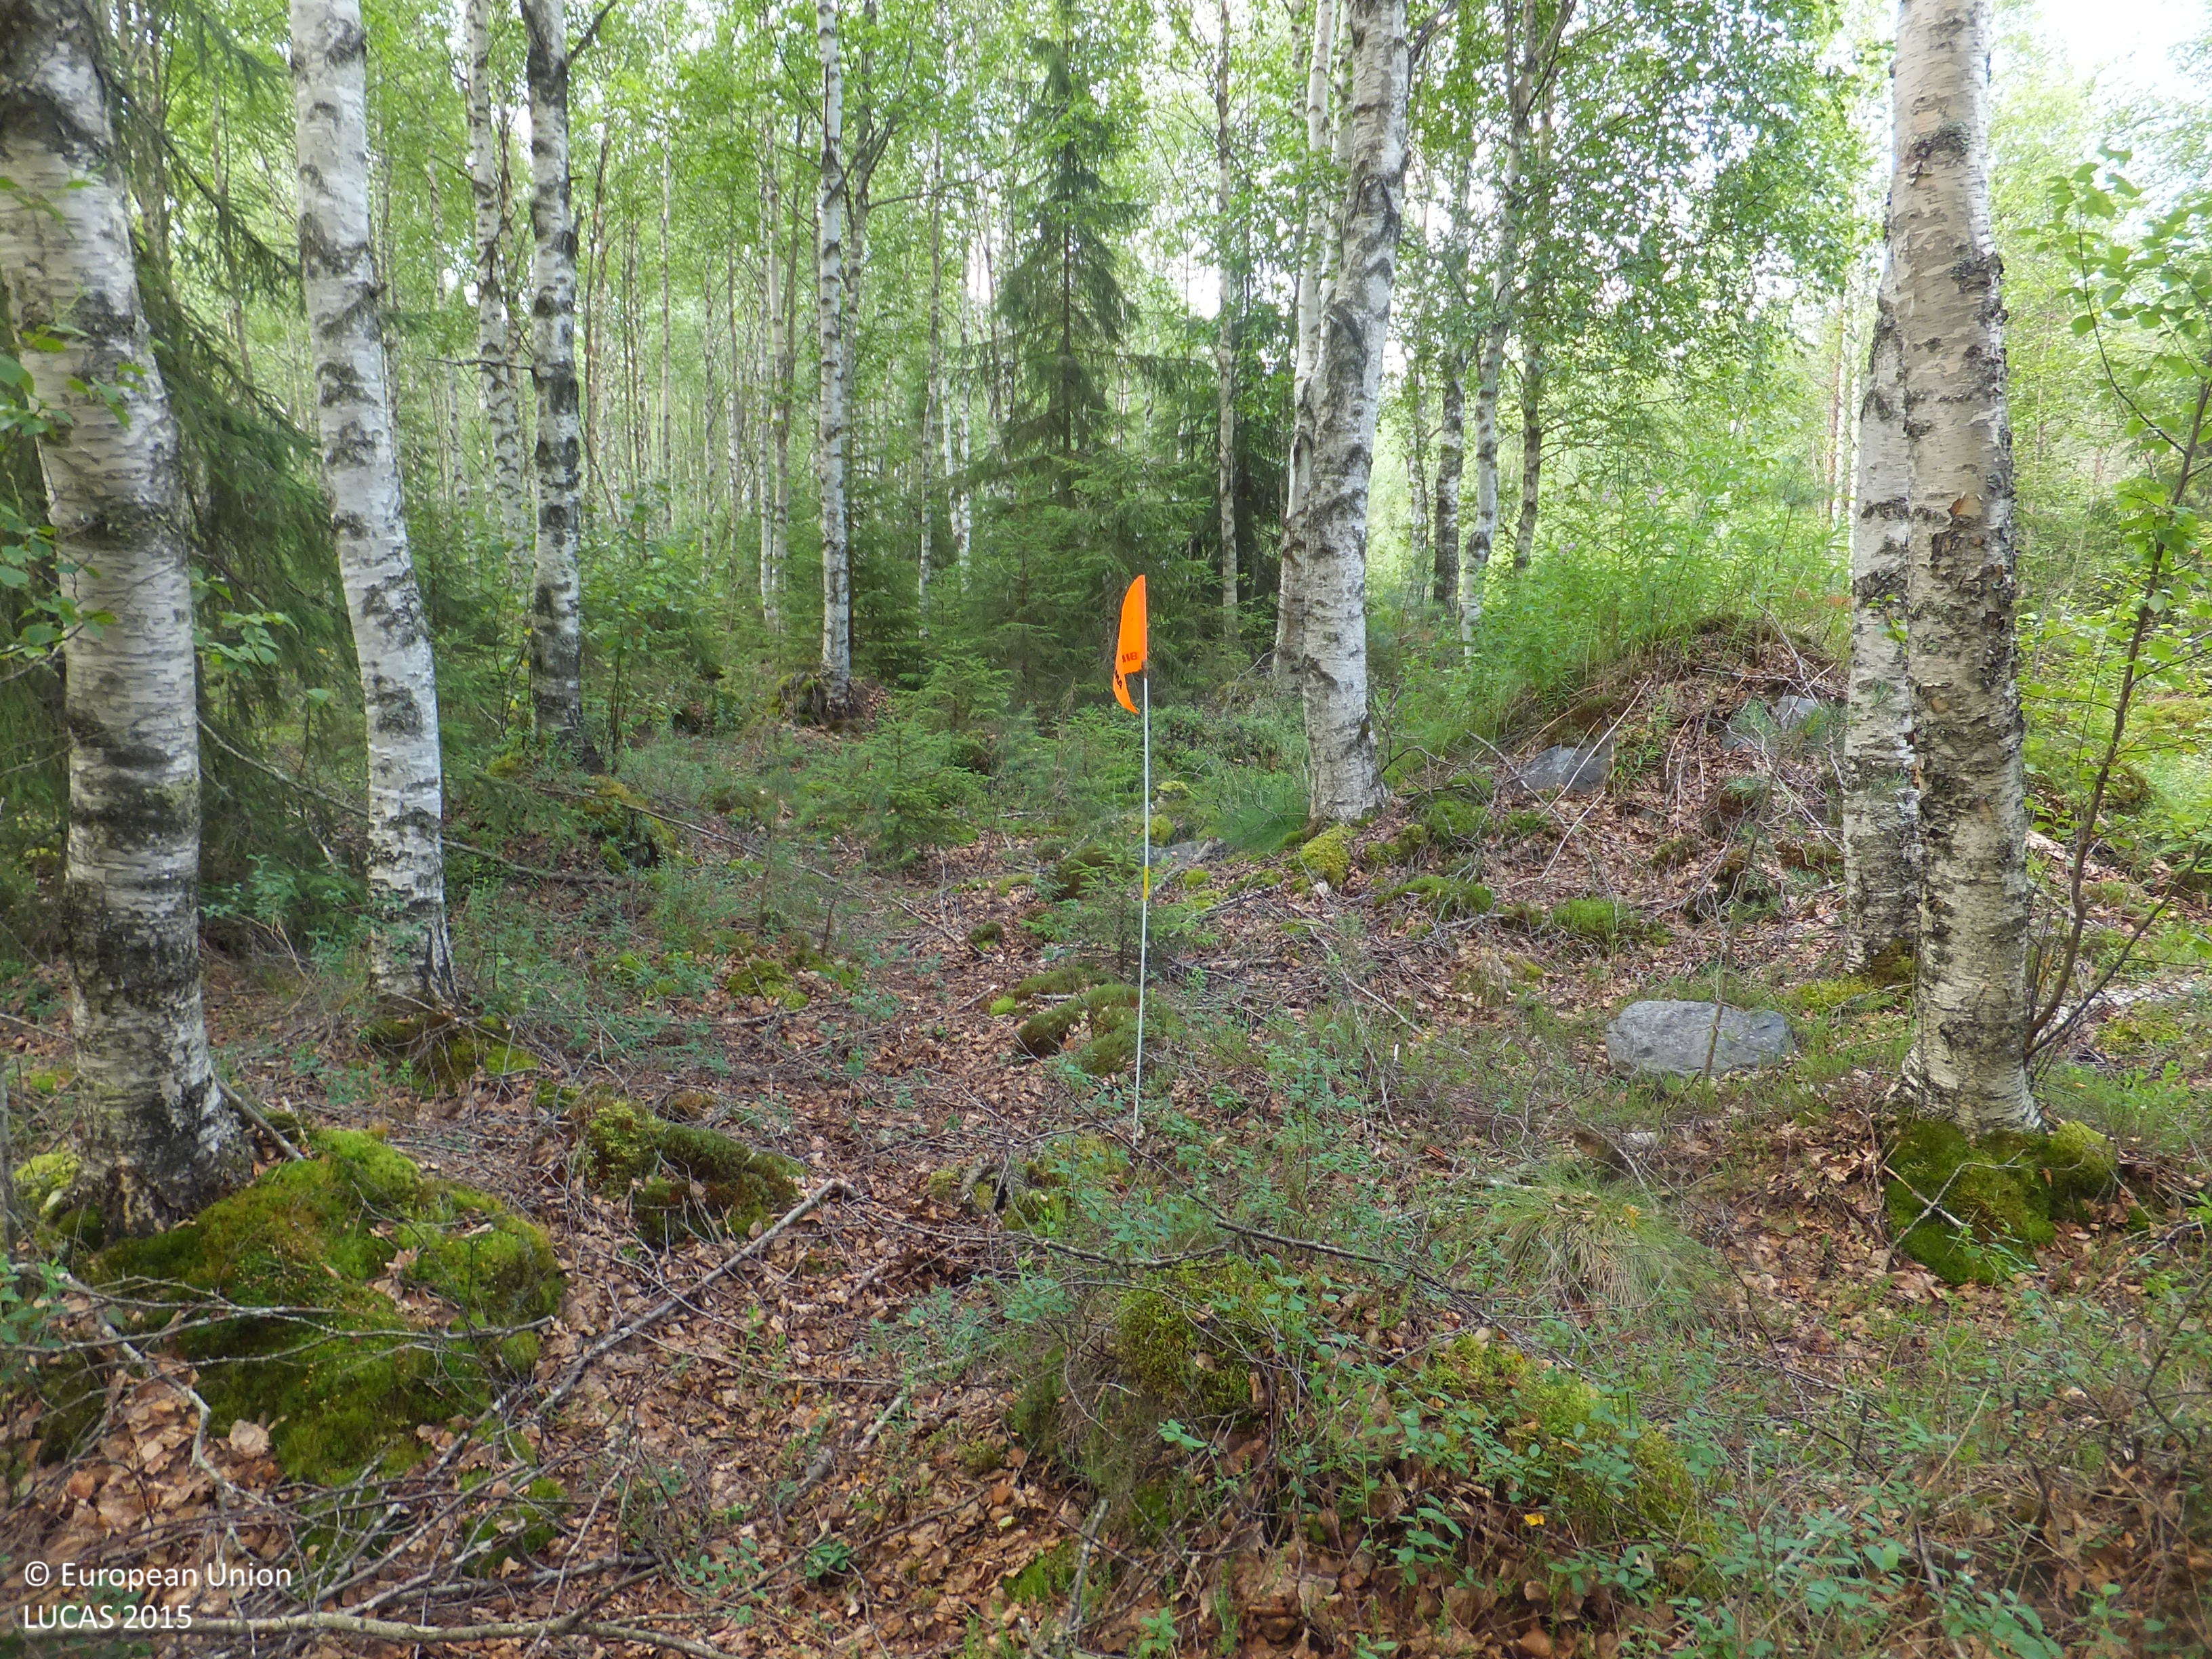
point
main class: Woodland
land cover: Spruce dominated mixed woodland
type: boreal forest
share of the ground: > 75 %
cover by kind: broadleaved forest trees 50 %, coniferous forest trees 40 %, shrubs 5 %, lichens and mosses 5 %
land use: Forestry
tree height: > 5 m
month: July
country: FI
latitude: 63.6211
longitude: 23.2296
